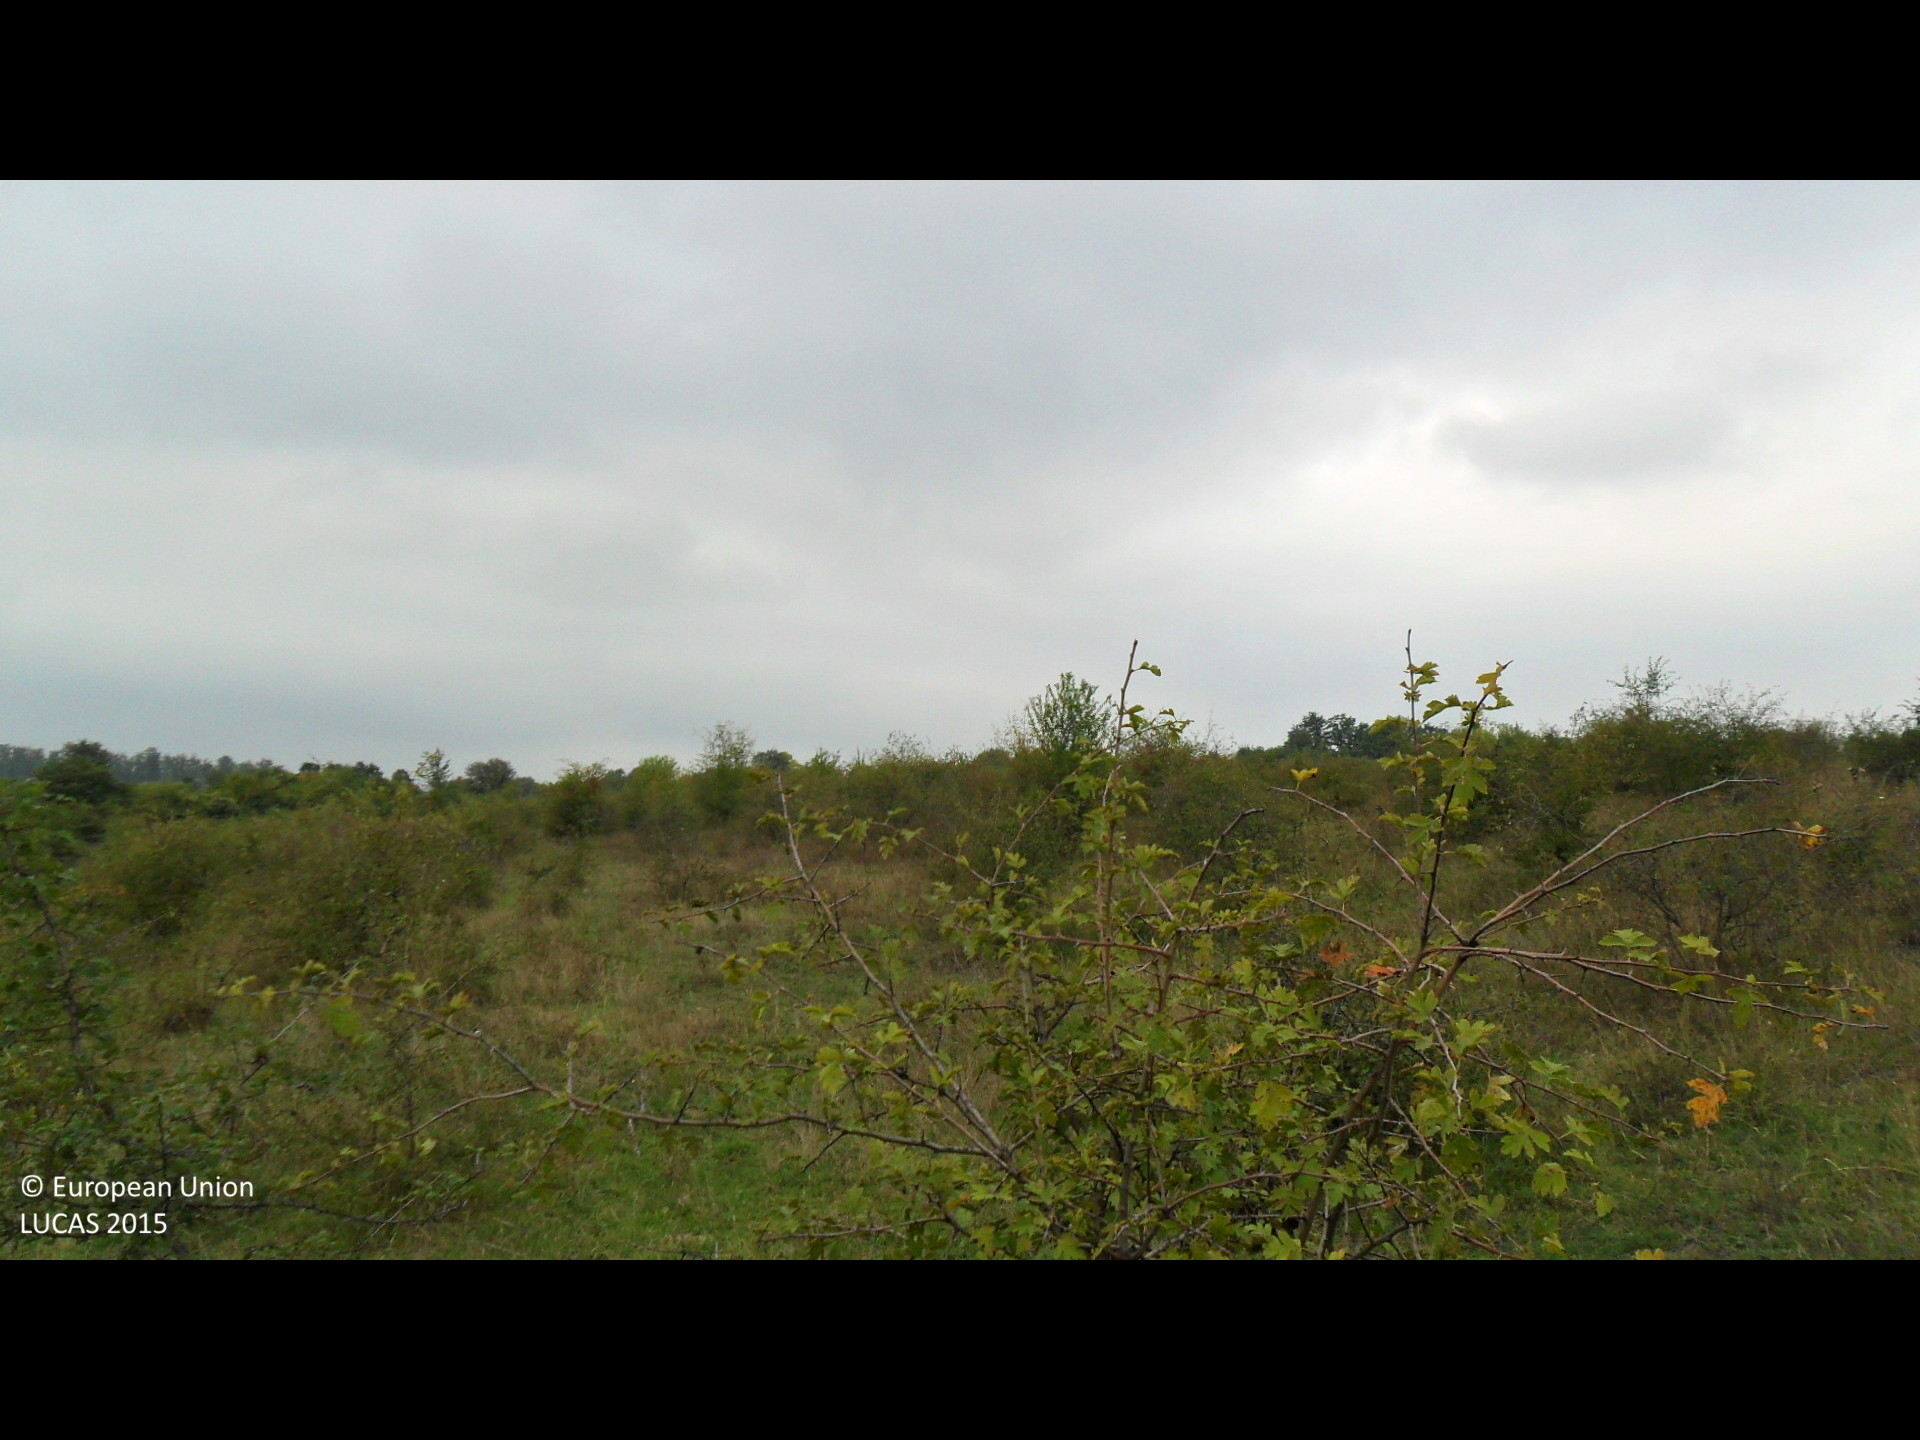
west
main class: Grassland
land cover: Grassland with sparse tree/shrub cover
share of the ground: > 75 %
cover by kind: herbaceous plants 90 %, broadleaved forest trees 5 %, shrubs 5 %
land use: Agriculture (excluding fallow land and kitchen gardens)
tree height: < 5 m
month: September
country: BG
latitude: 43.1273
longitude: 26.2837
